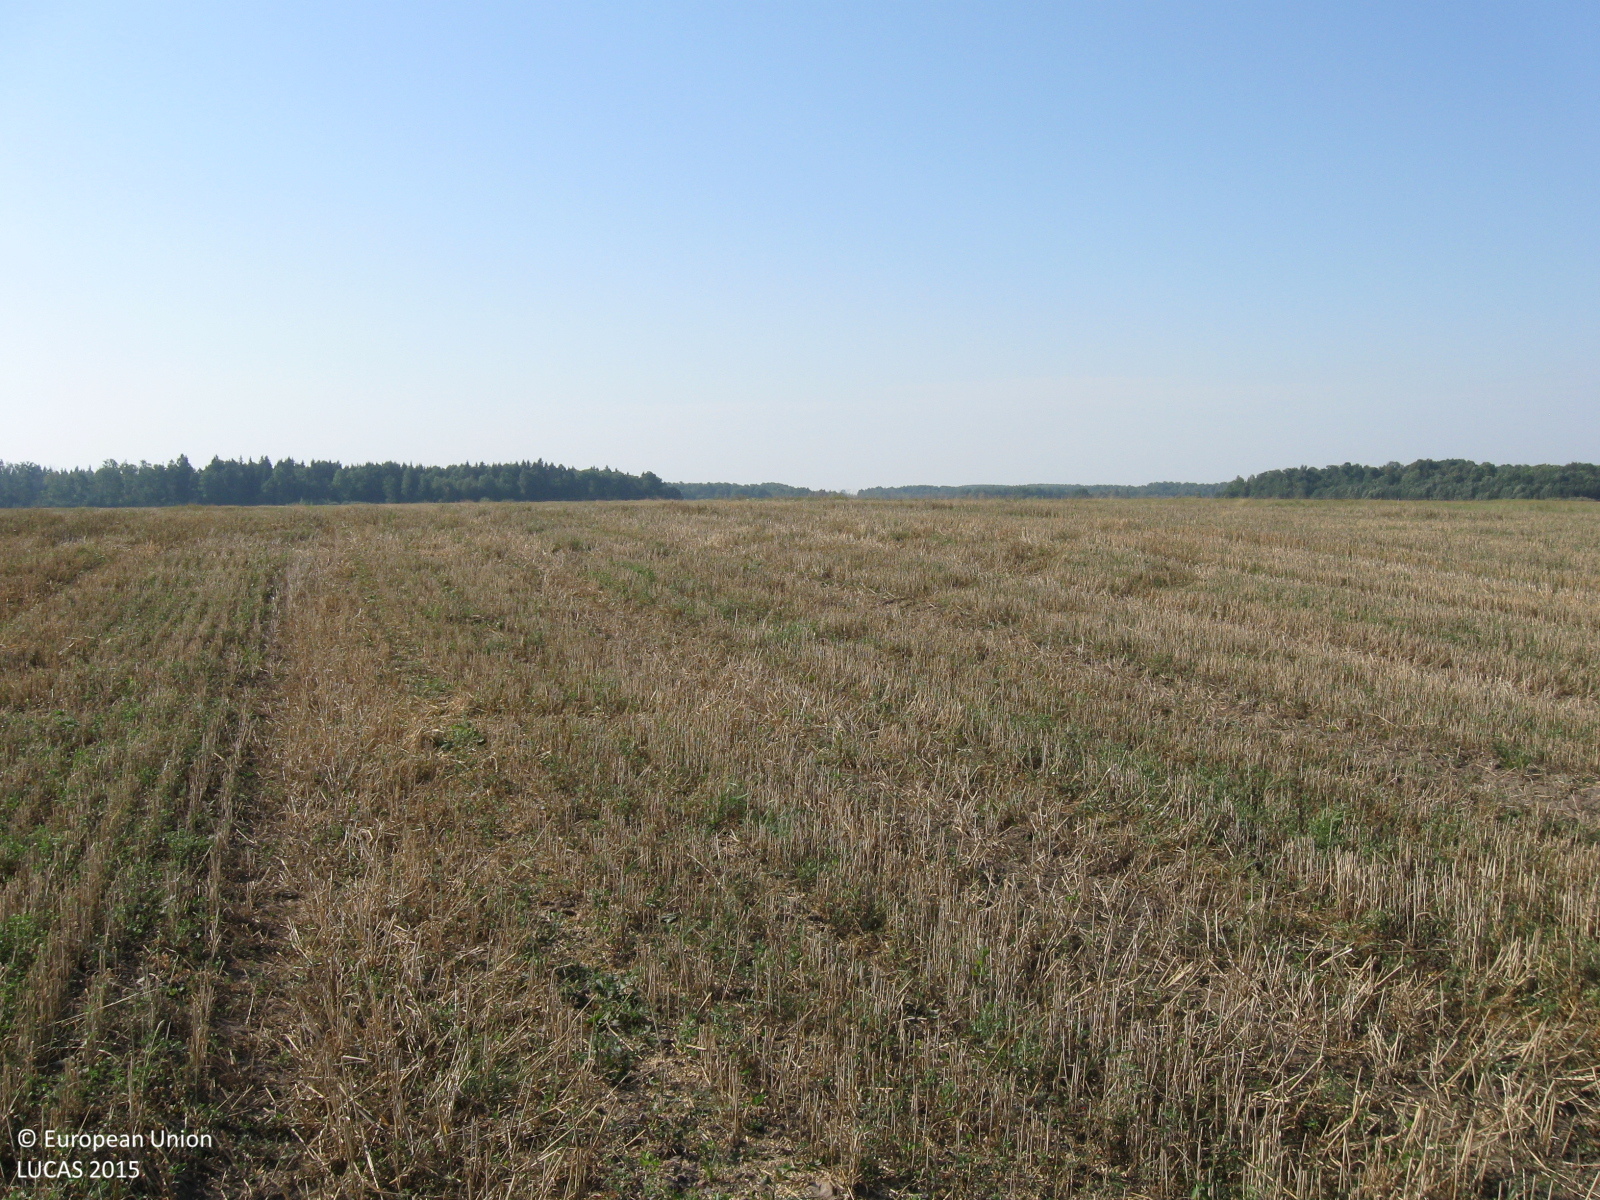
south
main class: Cropland
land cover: Common wheat
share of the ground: > 75 %
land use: Agriculture (excluding fallow land and kitchen gardens)
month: August
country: LT
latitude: 55.5040
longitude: 23.0047
